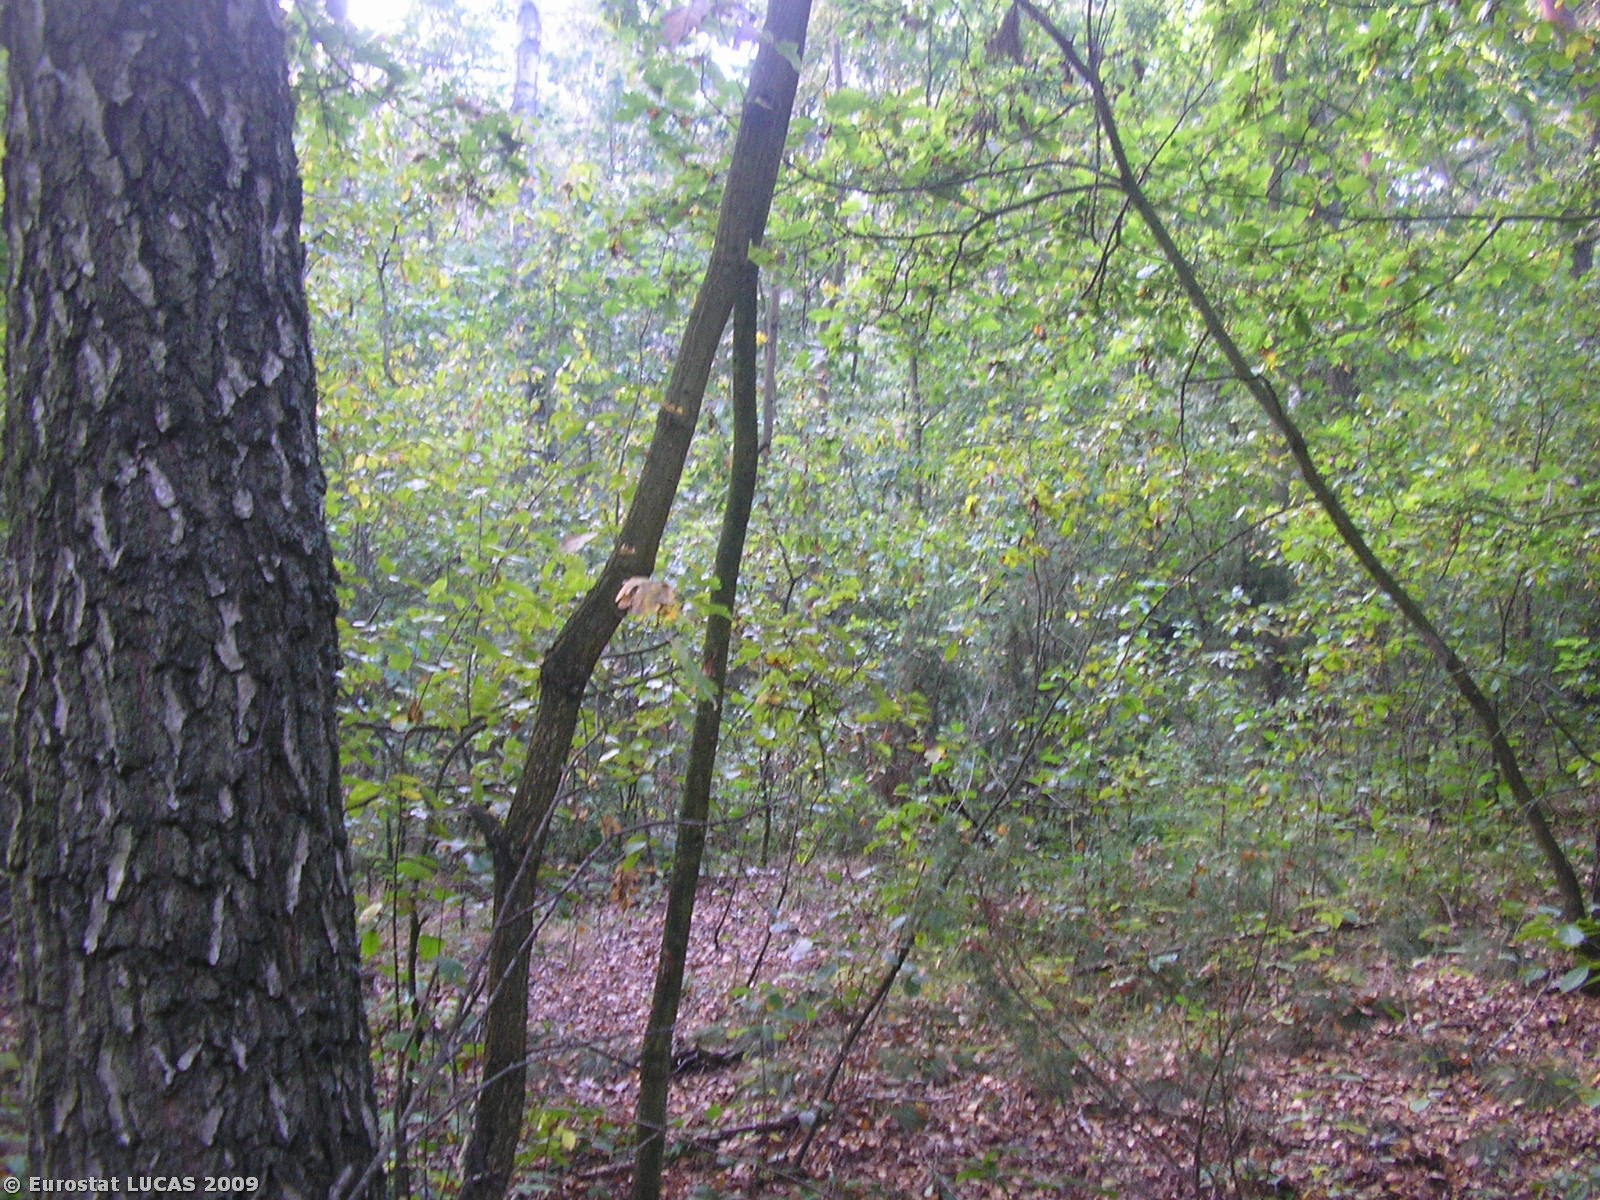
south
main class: Woodland
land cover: Mixed woodland
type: hemiboreal forest and nemoral coniferous forest and mixed broadleaved-coniferous forest
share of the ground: > 75 %
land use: Forestry
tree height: > 5 m
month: September
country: PL
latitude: 51.8701
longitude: 20.7452
